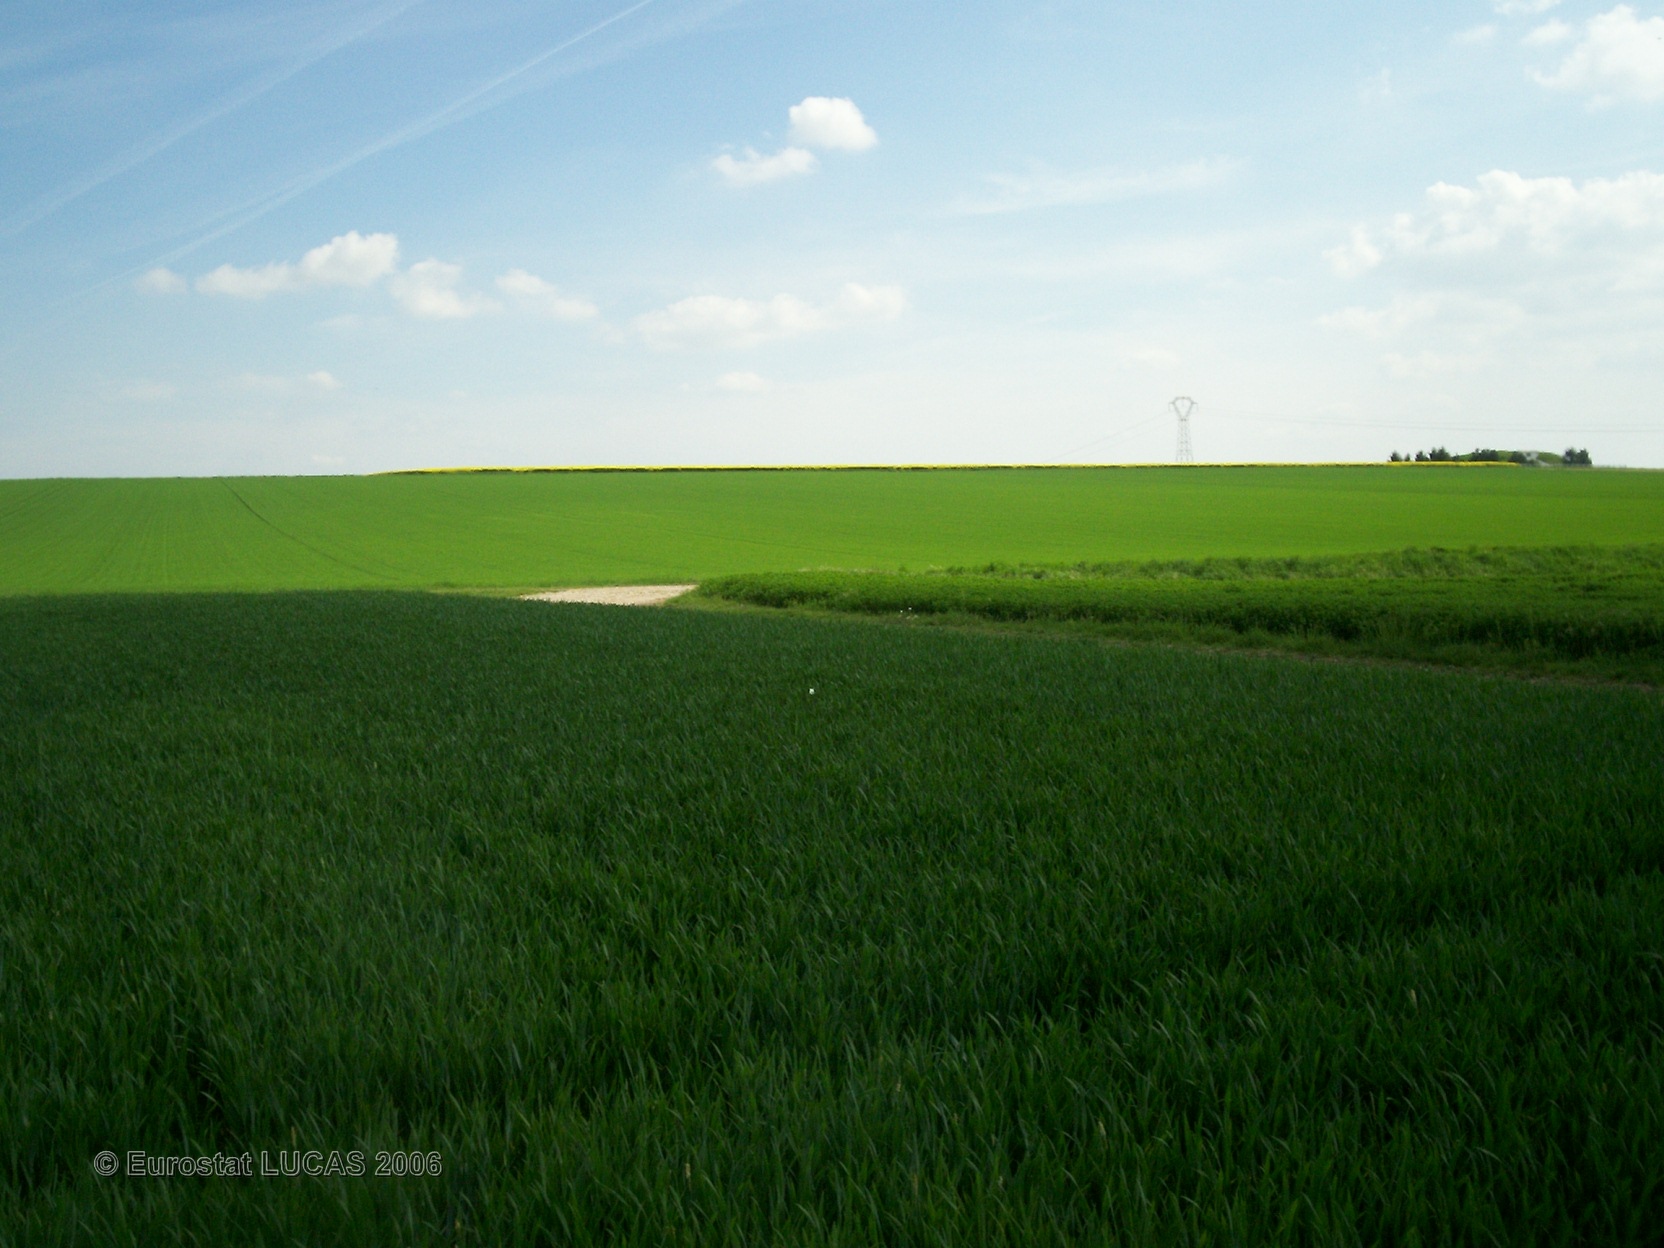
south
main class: Cropland
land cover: Common wheat
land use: Agriculture (excluding fallow land and kitchen gardens)
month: May
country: FR
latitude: 48.9143
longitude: 4.4703
